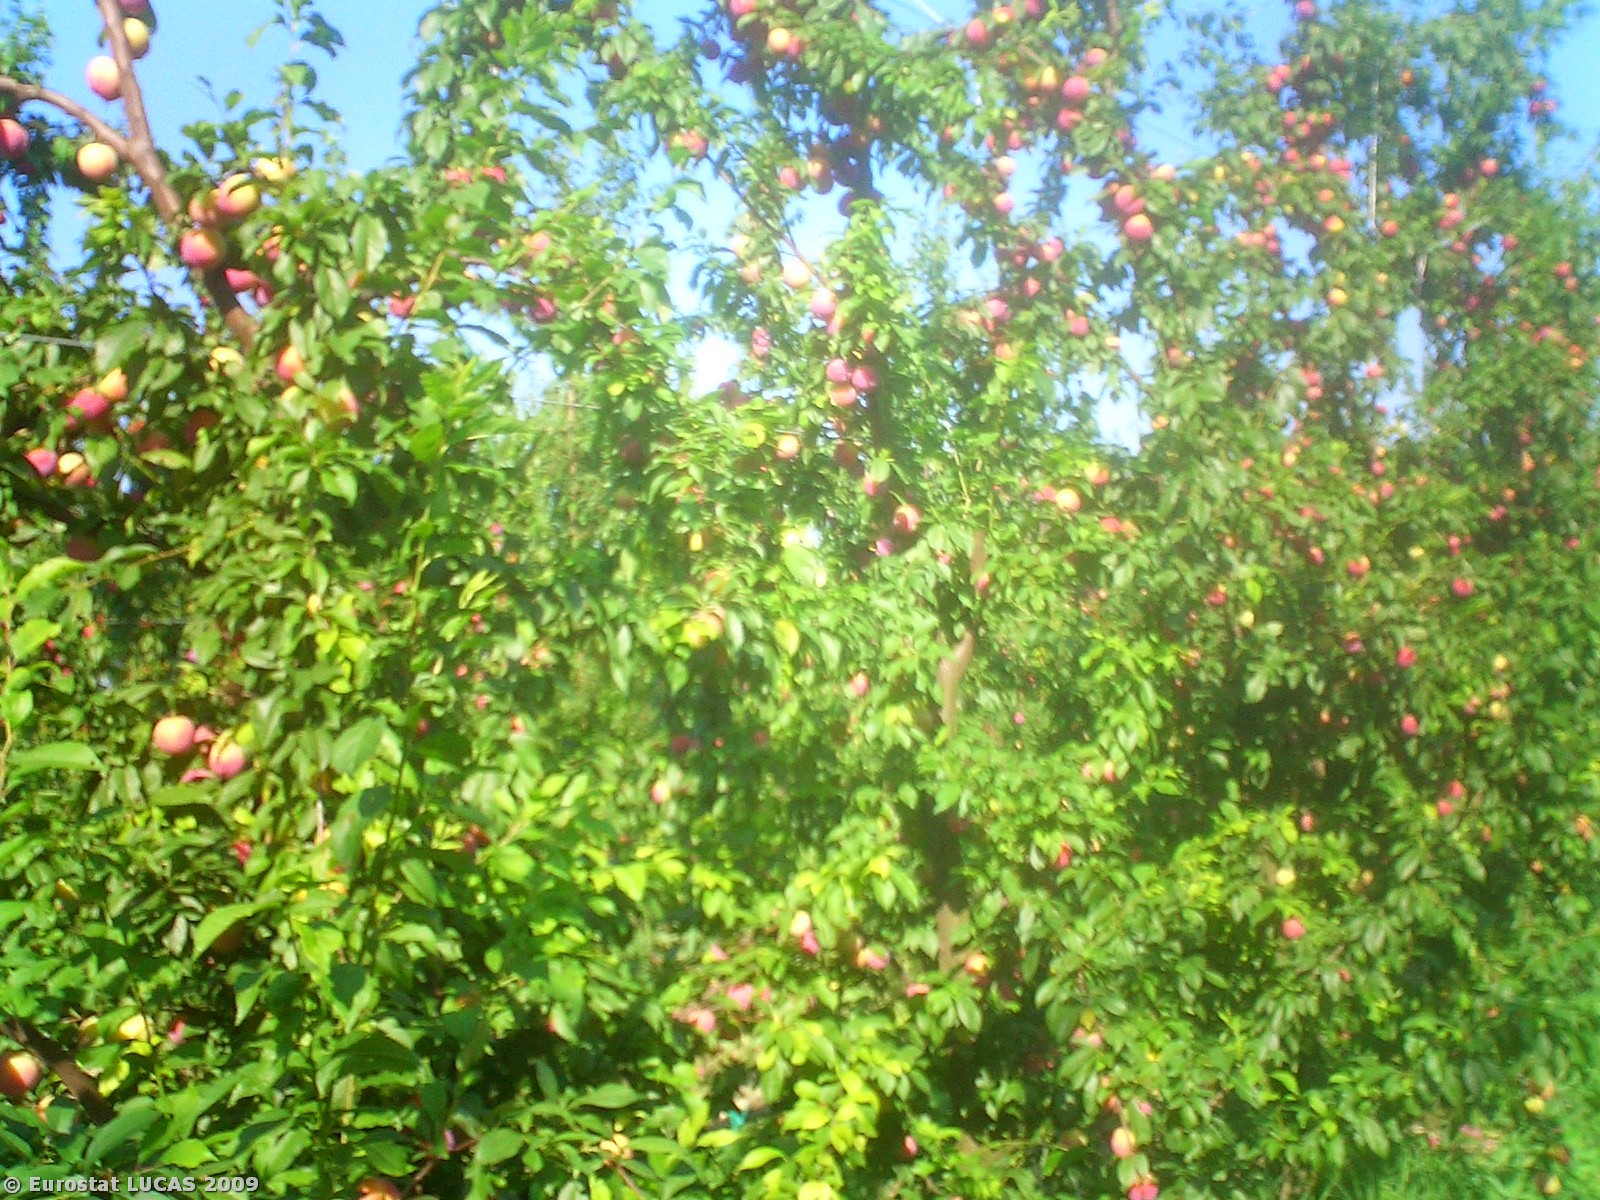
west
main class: Cropland
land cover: Other fruit trees and berries
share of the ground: 50 - 75 %
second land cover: Grassland with sparse tree/shrub cover
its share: 50 - 75 %
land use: Agriculture (excluding fallow land and kitchen gardens)
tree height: < 5 m
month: July
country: IT
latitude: 44.3320
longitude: 11.9646
